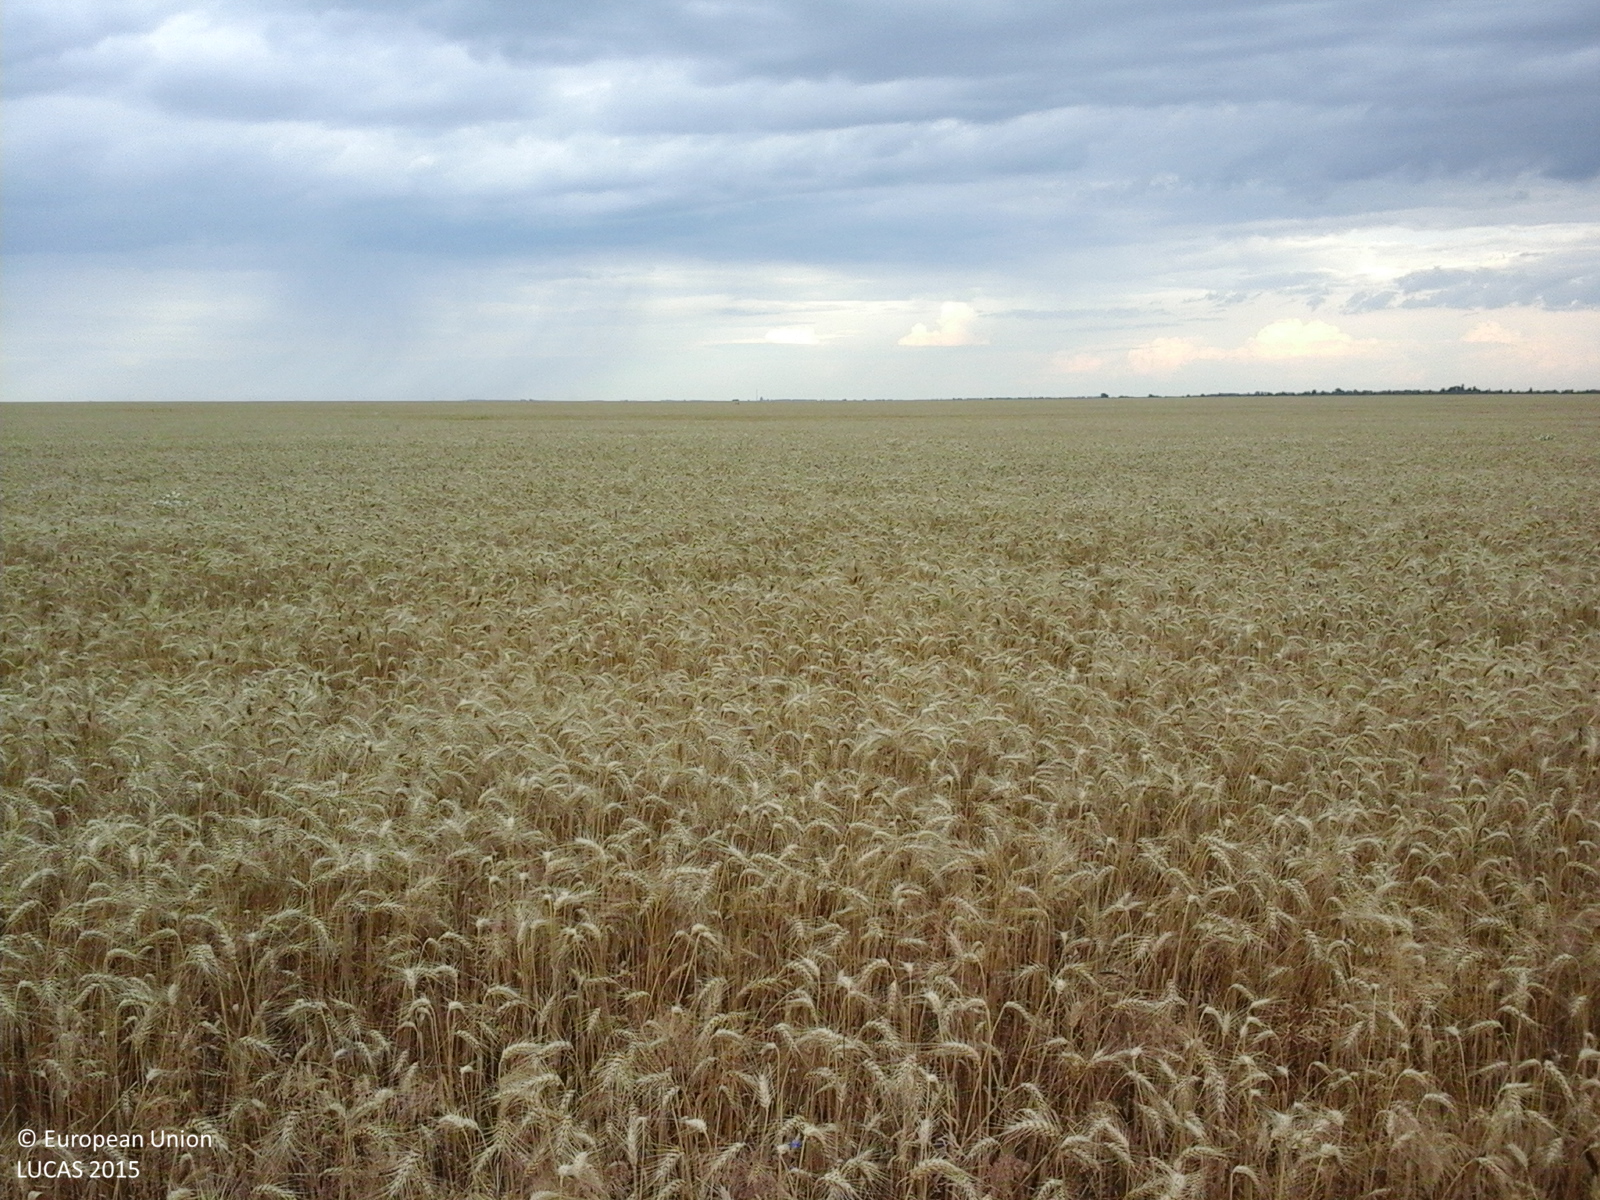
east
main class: Cropland
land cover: Common wheat
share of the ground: > 75 %
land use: Agriculture (excluding fallow land and kitchen gardens)
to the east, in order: Common wheat
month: July
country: RO
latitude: 44.3600
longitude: 24.8188
